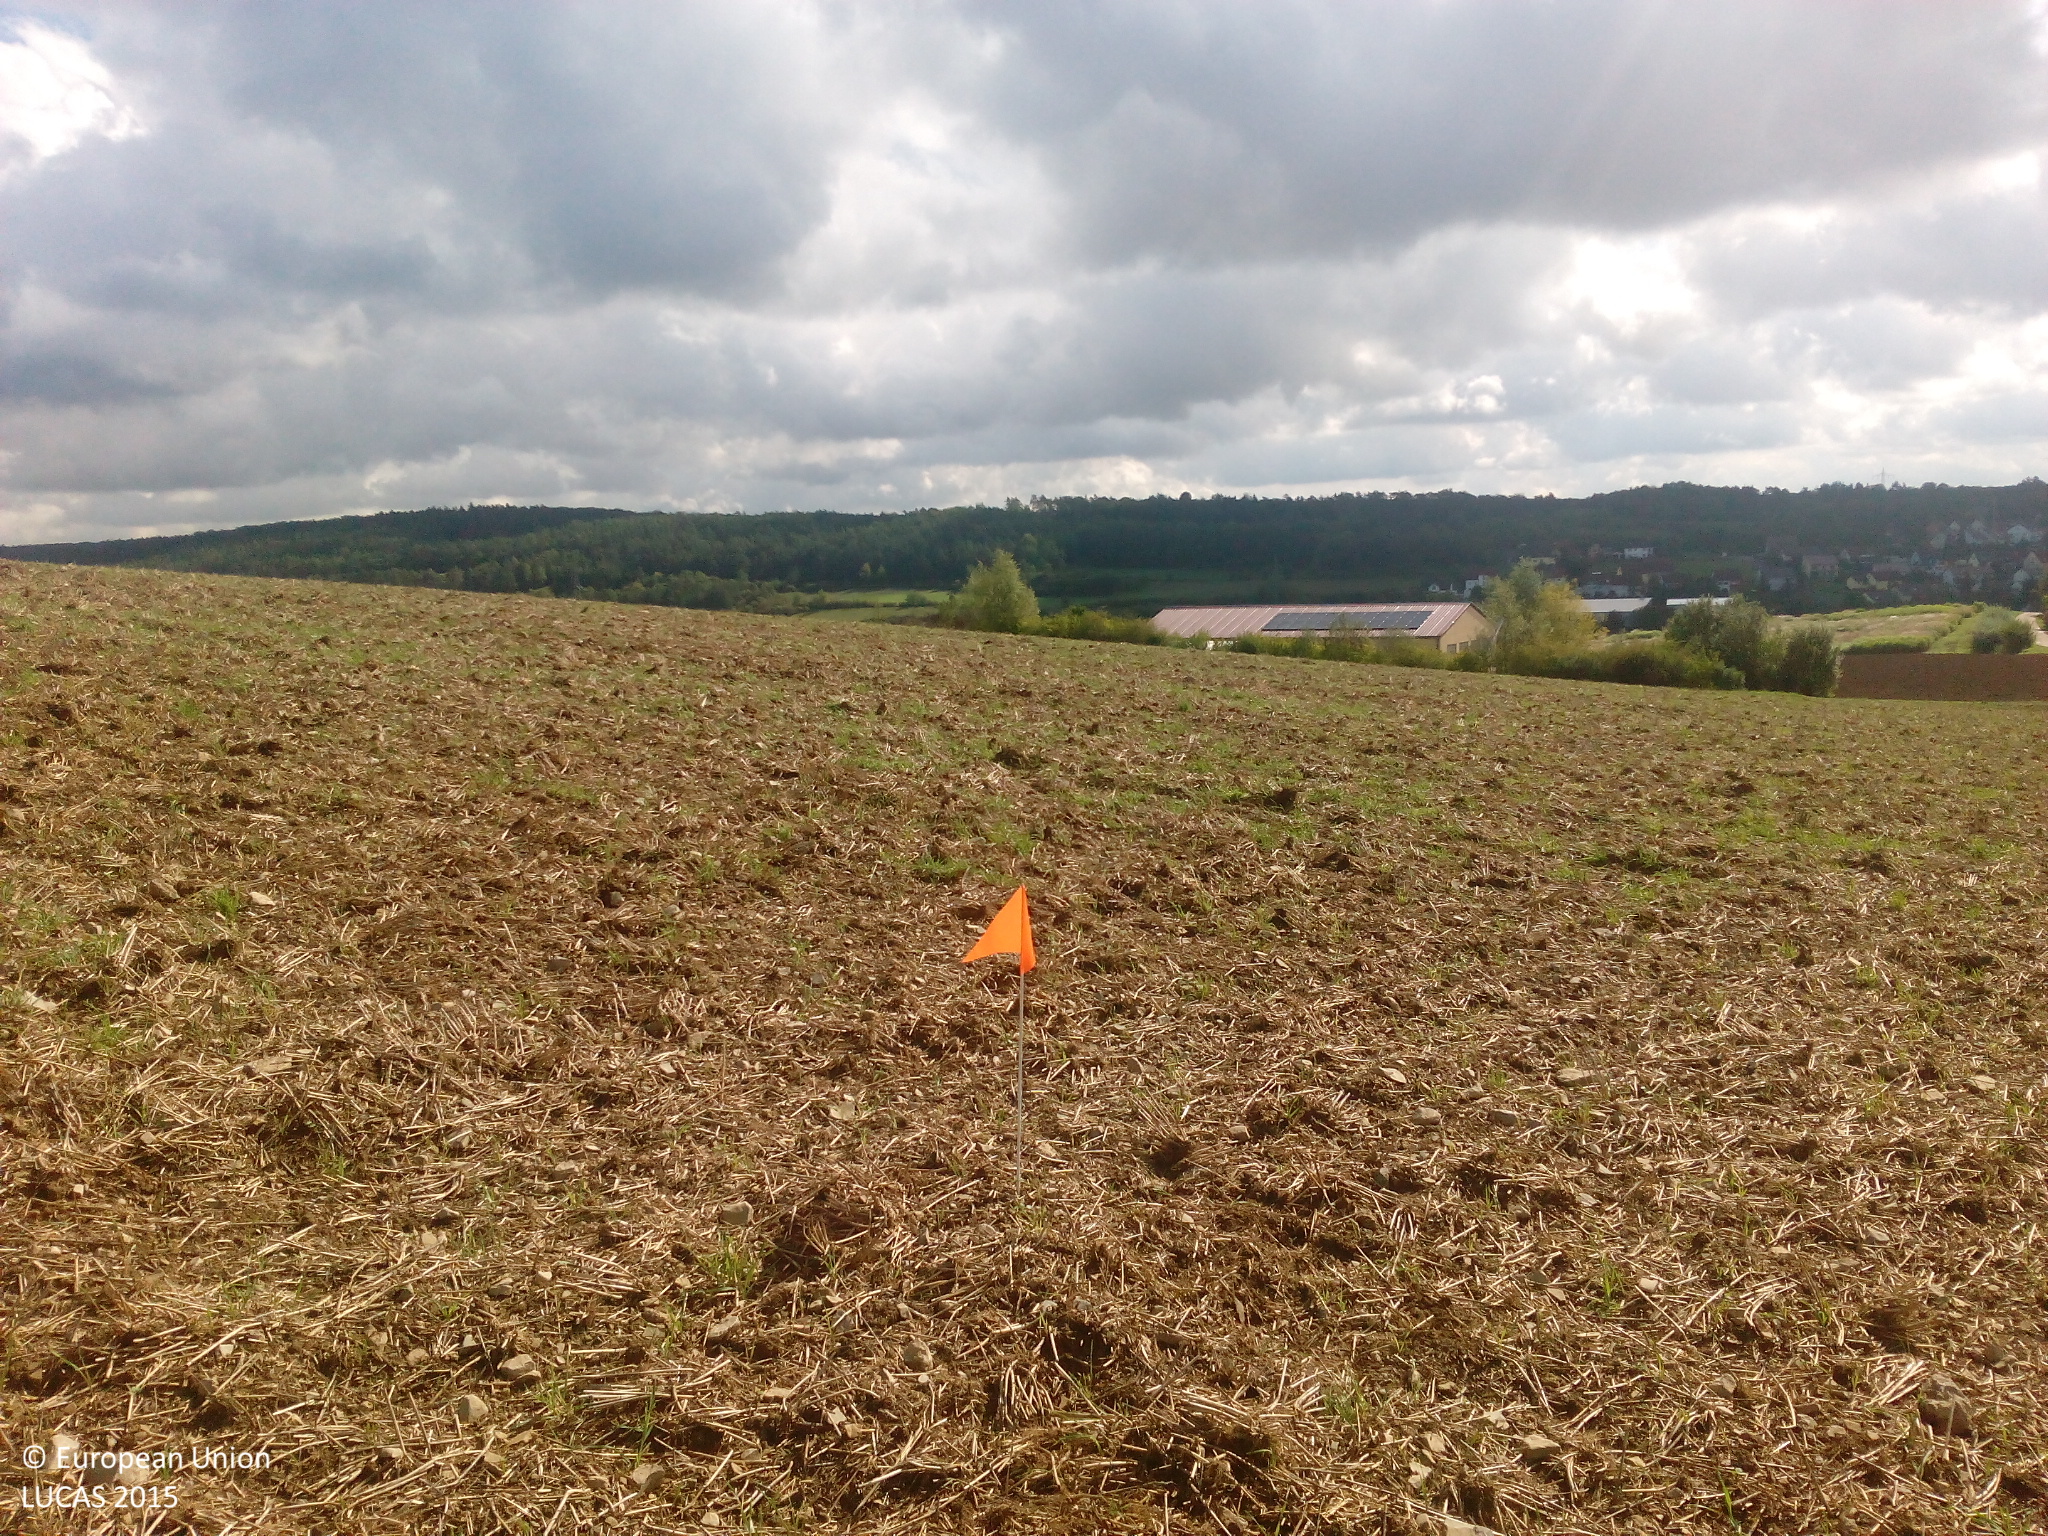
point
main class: Cropland
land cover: Common wheat
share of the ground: 10 - 25 %
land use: Agriculture (excluding fallow land and kitchen gardens)
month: September
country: DE
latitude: 49.8785
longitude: 9.9026
